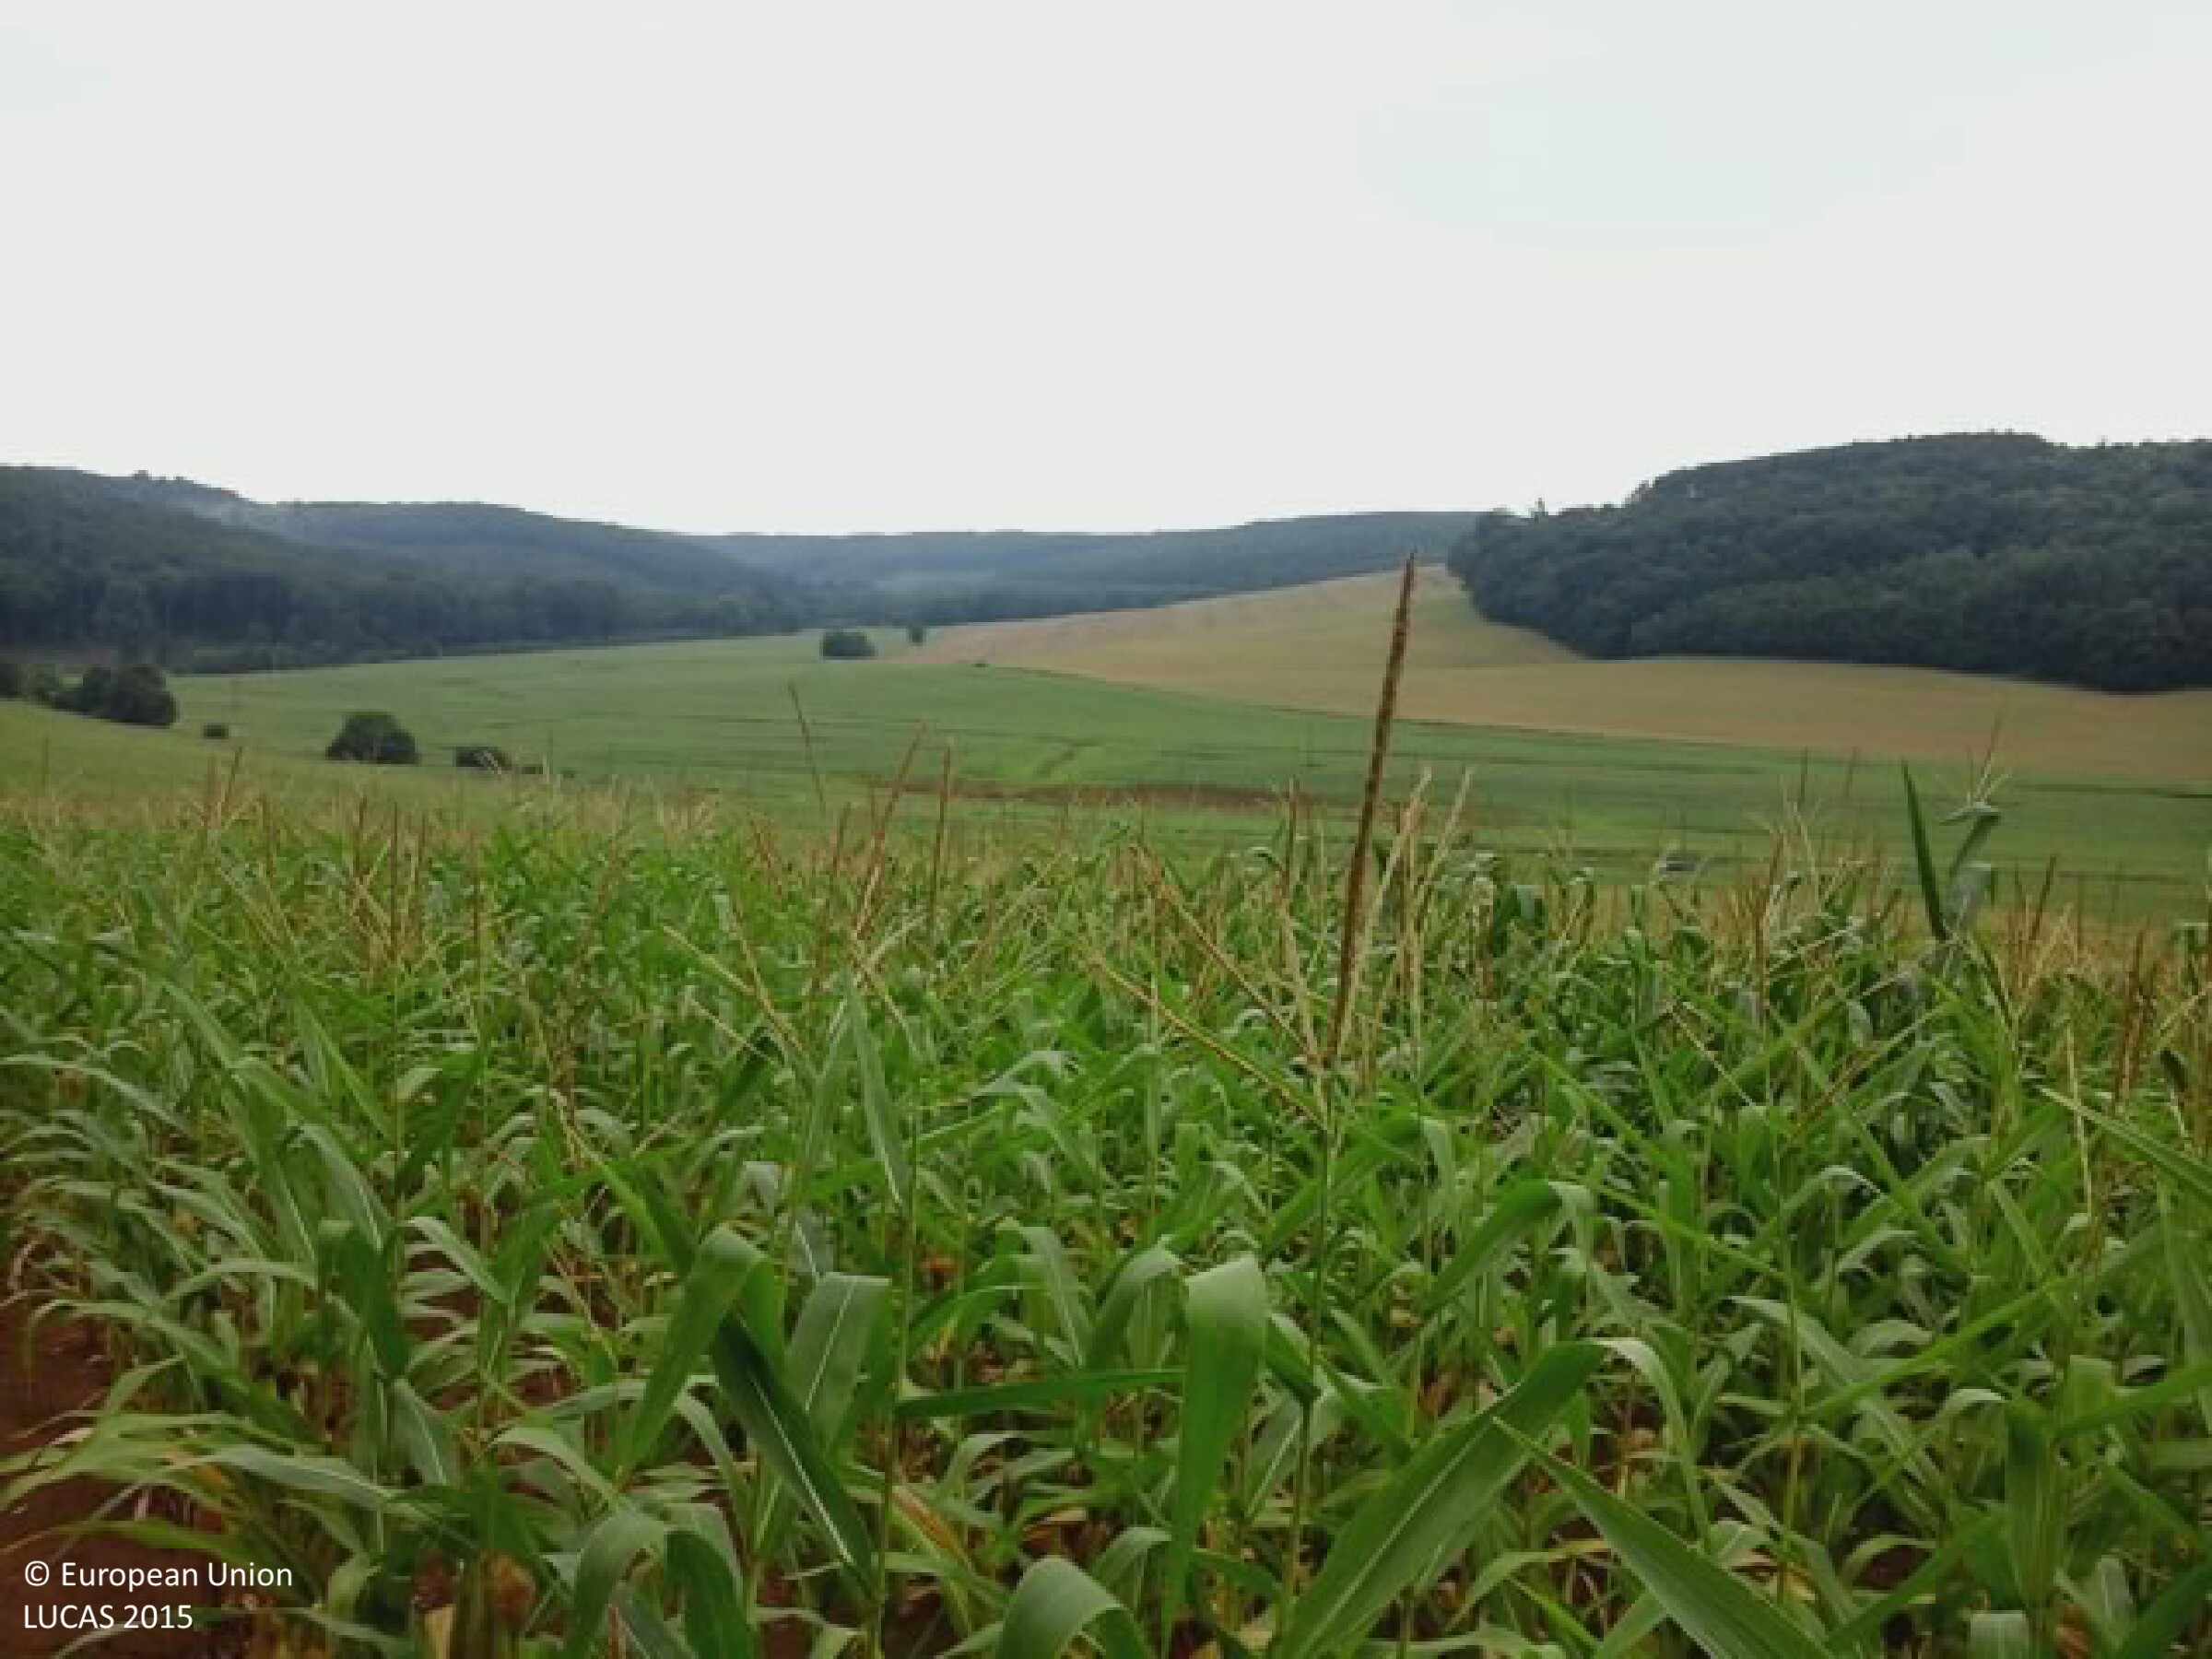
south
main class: Cropland
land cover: Maize
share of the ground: > 75 %
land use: Agriculture (excluding fallow land and kitchen gardens)
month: August
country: HU
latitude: 46.2176
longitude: 17.9527
